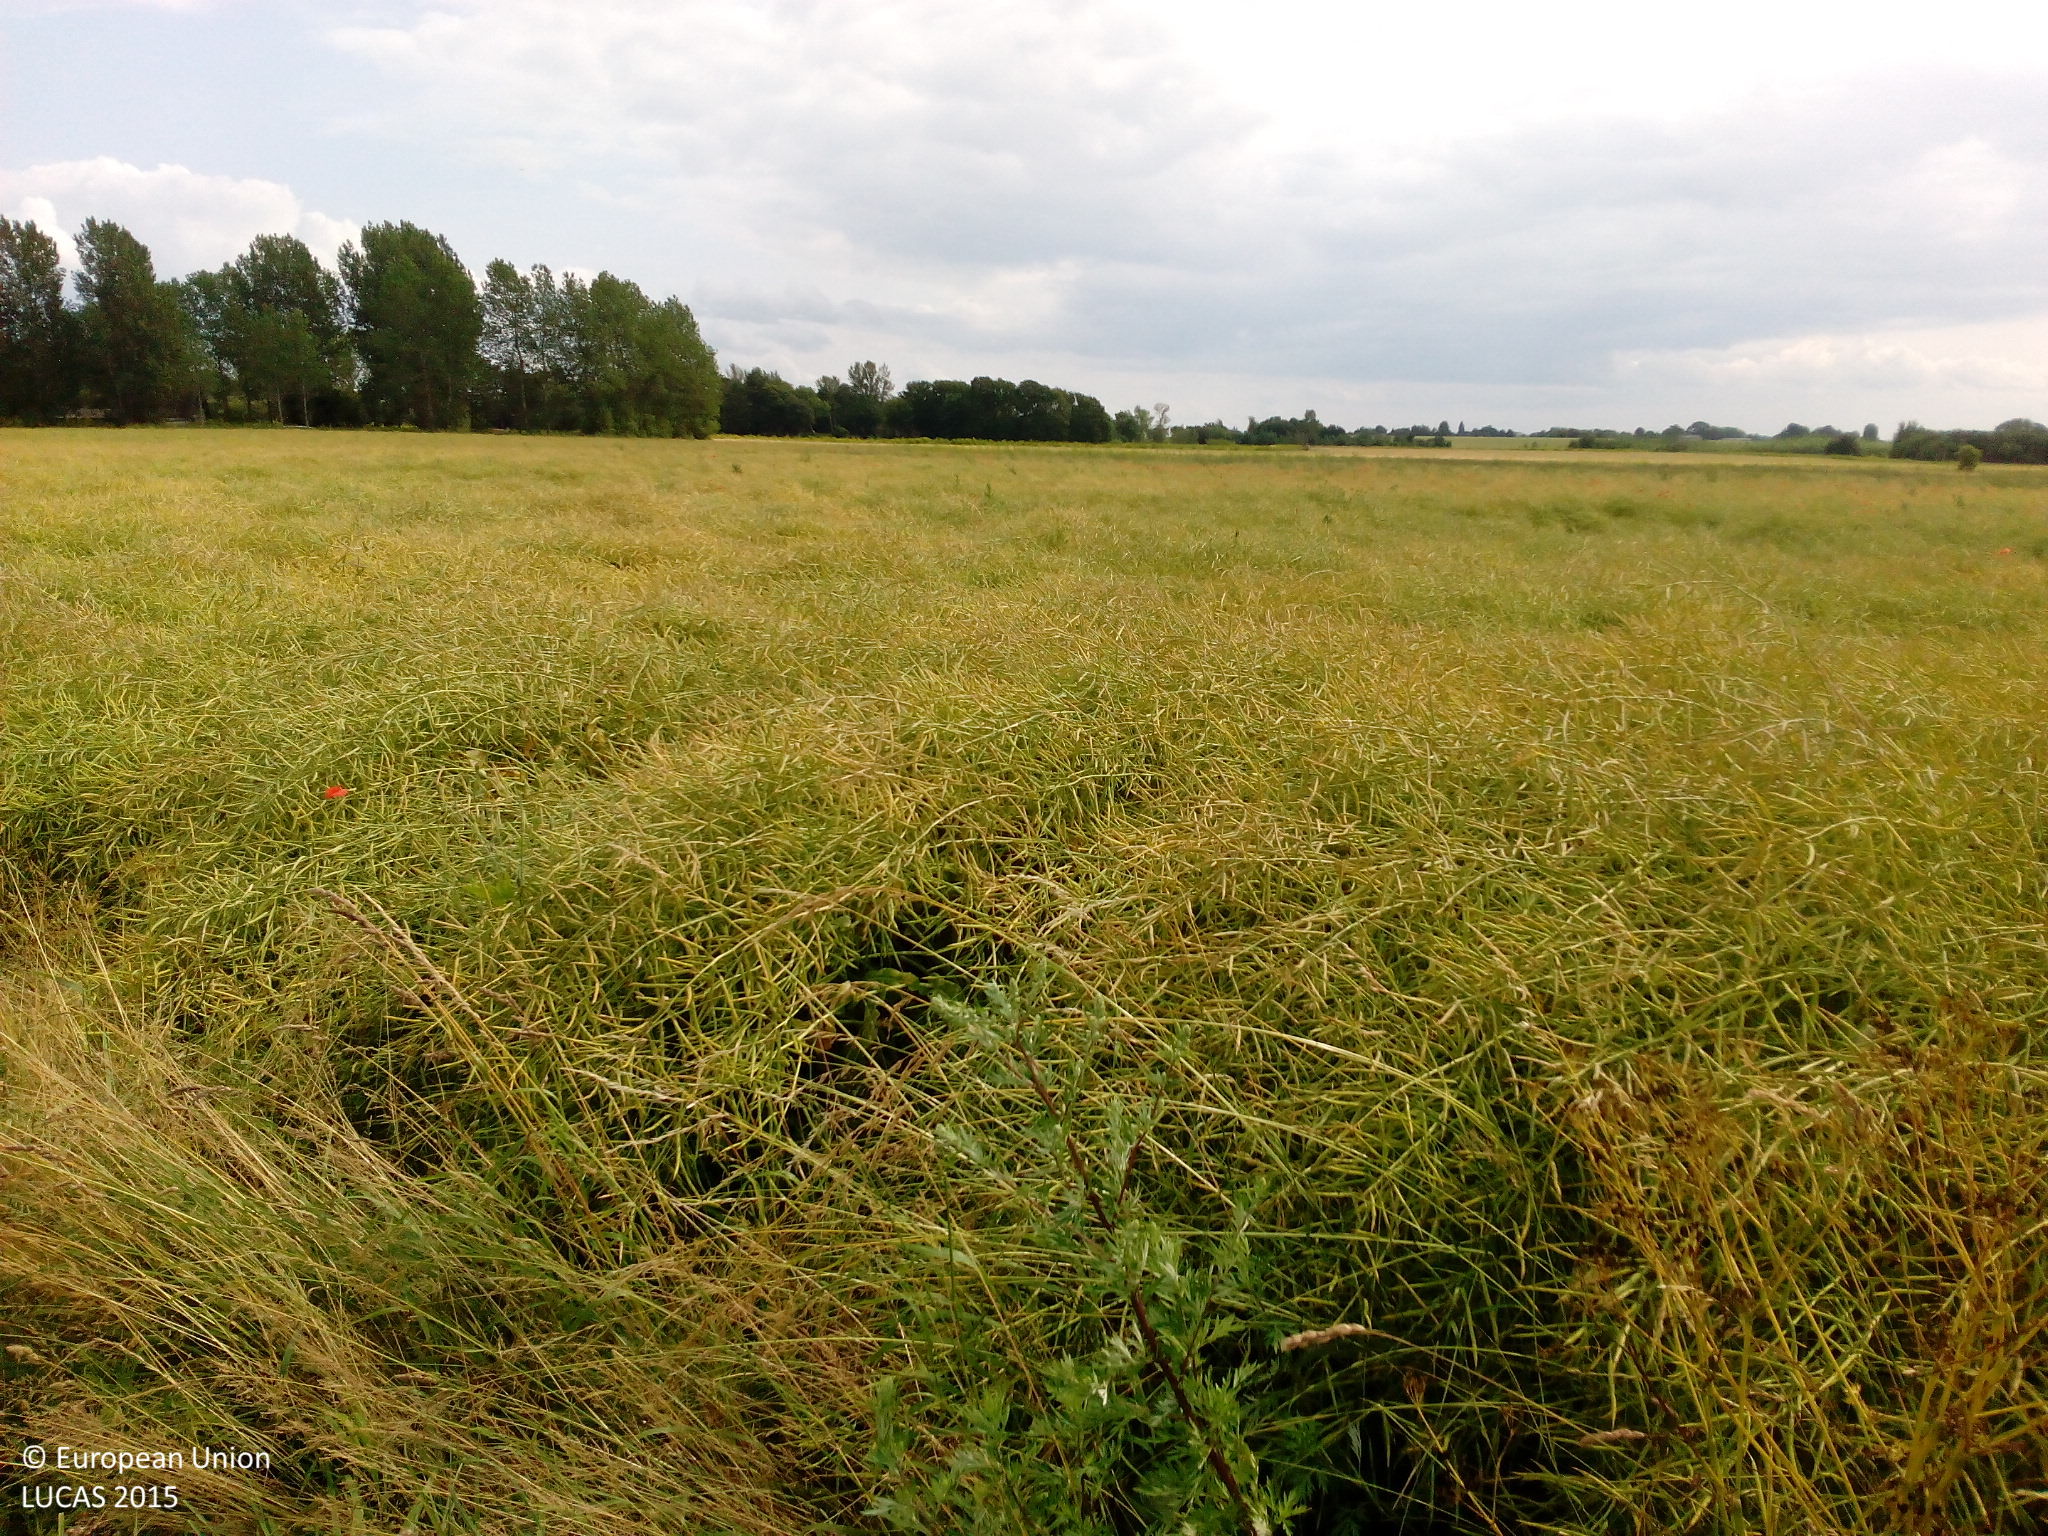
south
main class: Cropland
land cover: Rape and turnip rape
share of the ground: > 75 %
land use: Agriculture (excluding fallow land and kitchen gardens)
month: July
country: DK
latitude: 55.4985
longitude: 11.2494
